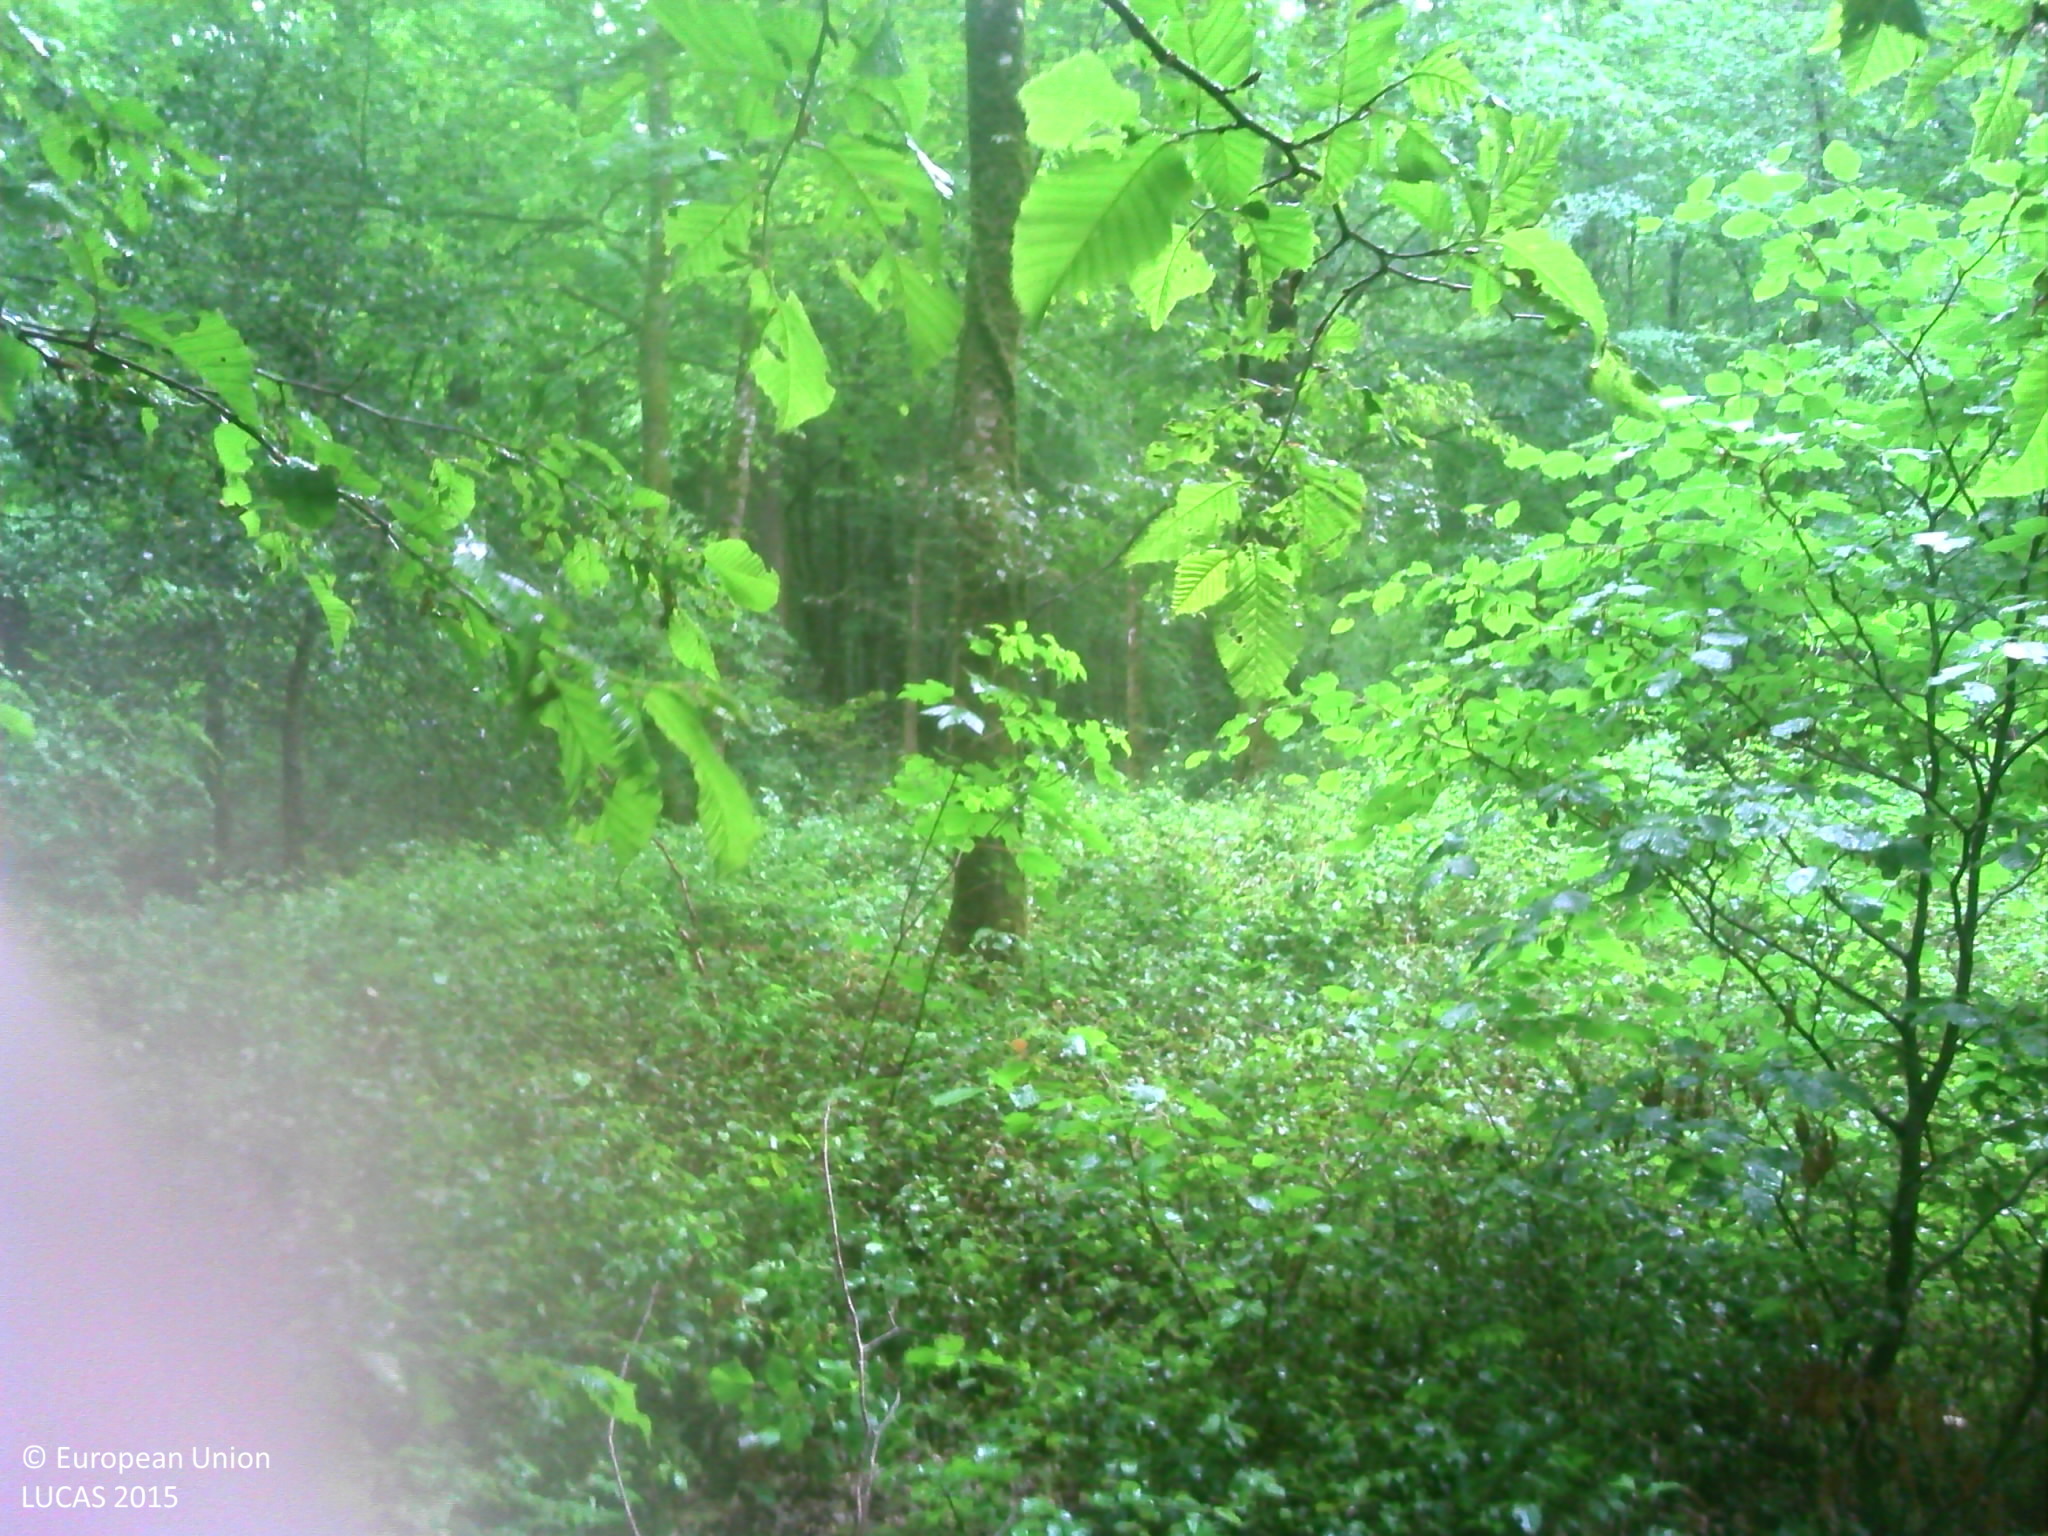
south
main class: Woodland
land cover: Broadleaved woodland
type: mesophytic deciduous forest
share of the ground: > 75 %
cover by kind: broadleaved forest trees 90 %, herbaceous plants 10 %
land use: Forestry
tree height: > 5 m
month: May
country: FR
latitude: 48.6121
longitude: 4.9389
